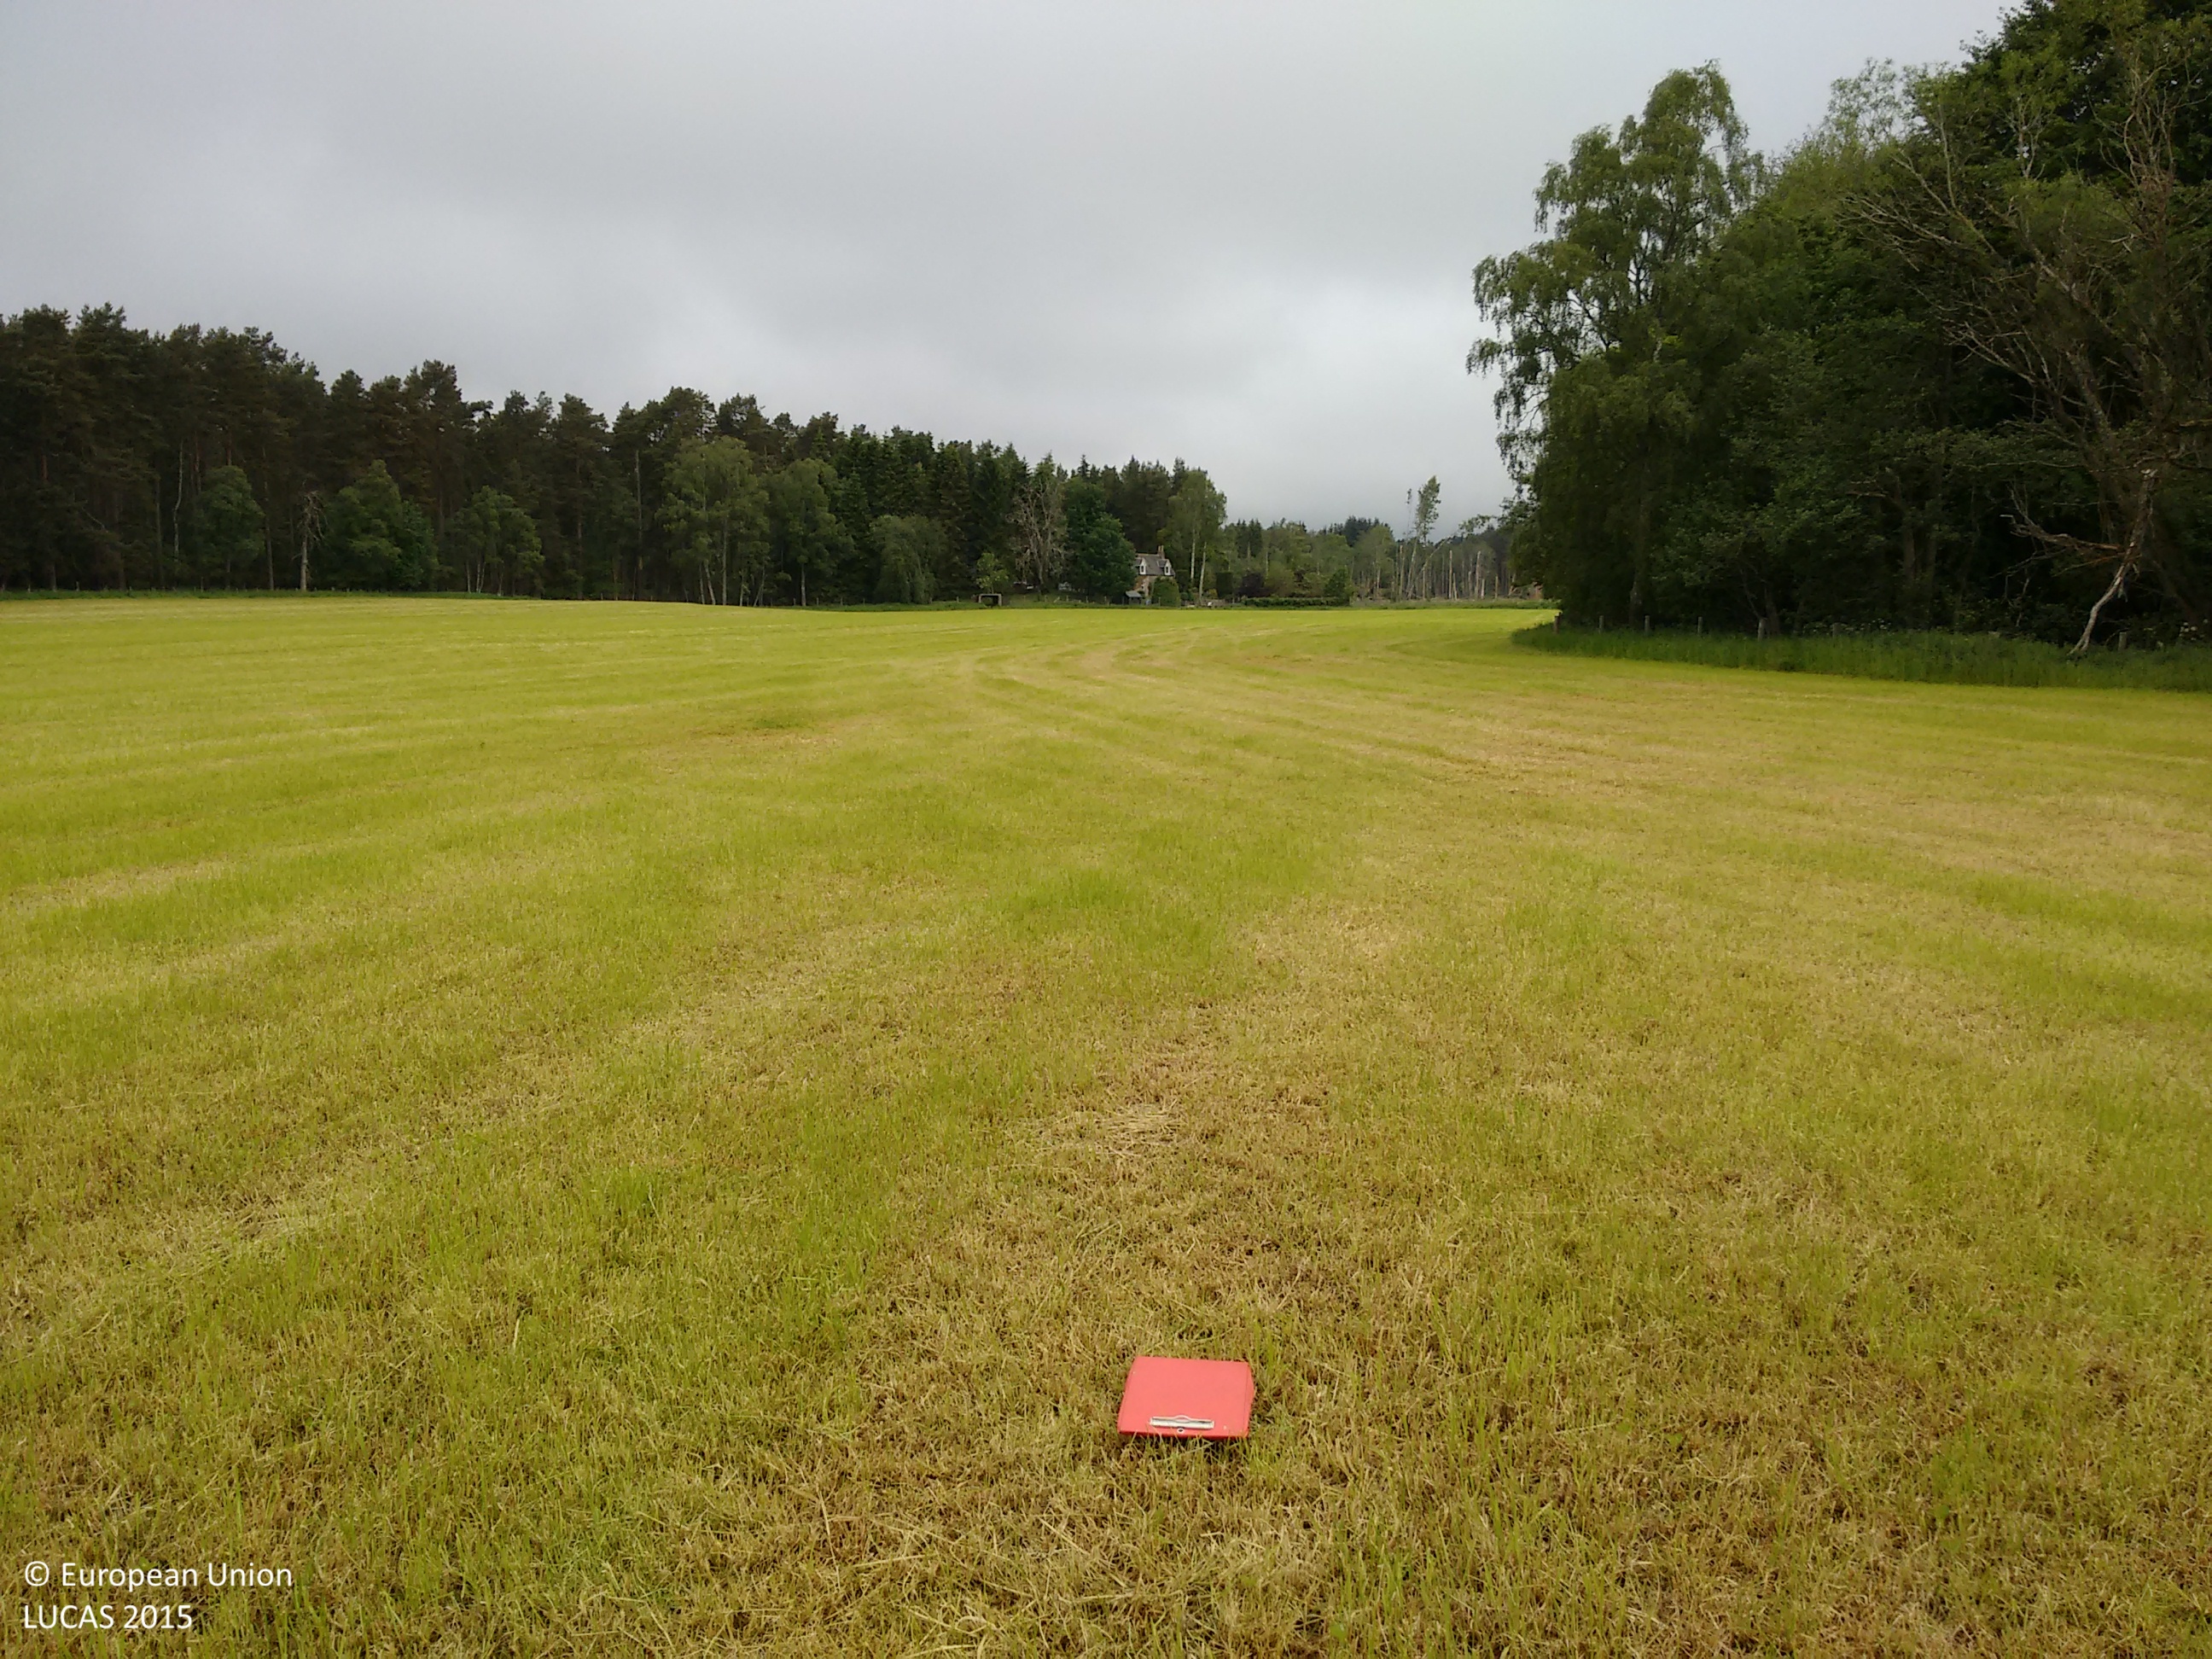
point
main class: Grassland
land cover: Grassland without tree/shrub cover
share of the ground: > 75 %
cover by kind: herbaceous plants 100 %
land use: Agriculture (excluding fallow land and kitchen gardens)
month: June
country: GB
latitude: 57.1173
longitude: -2.9267
